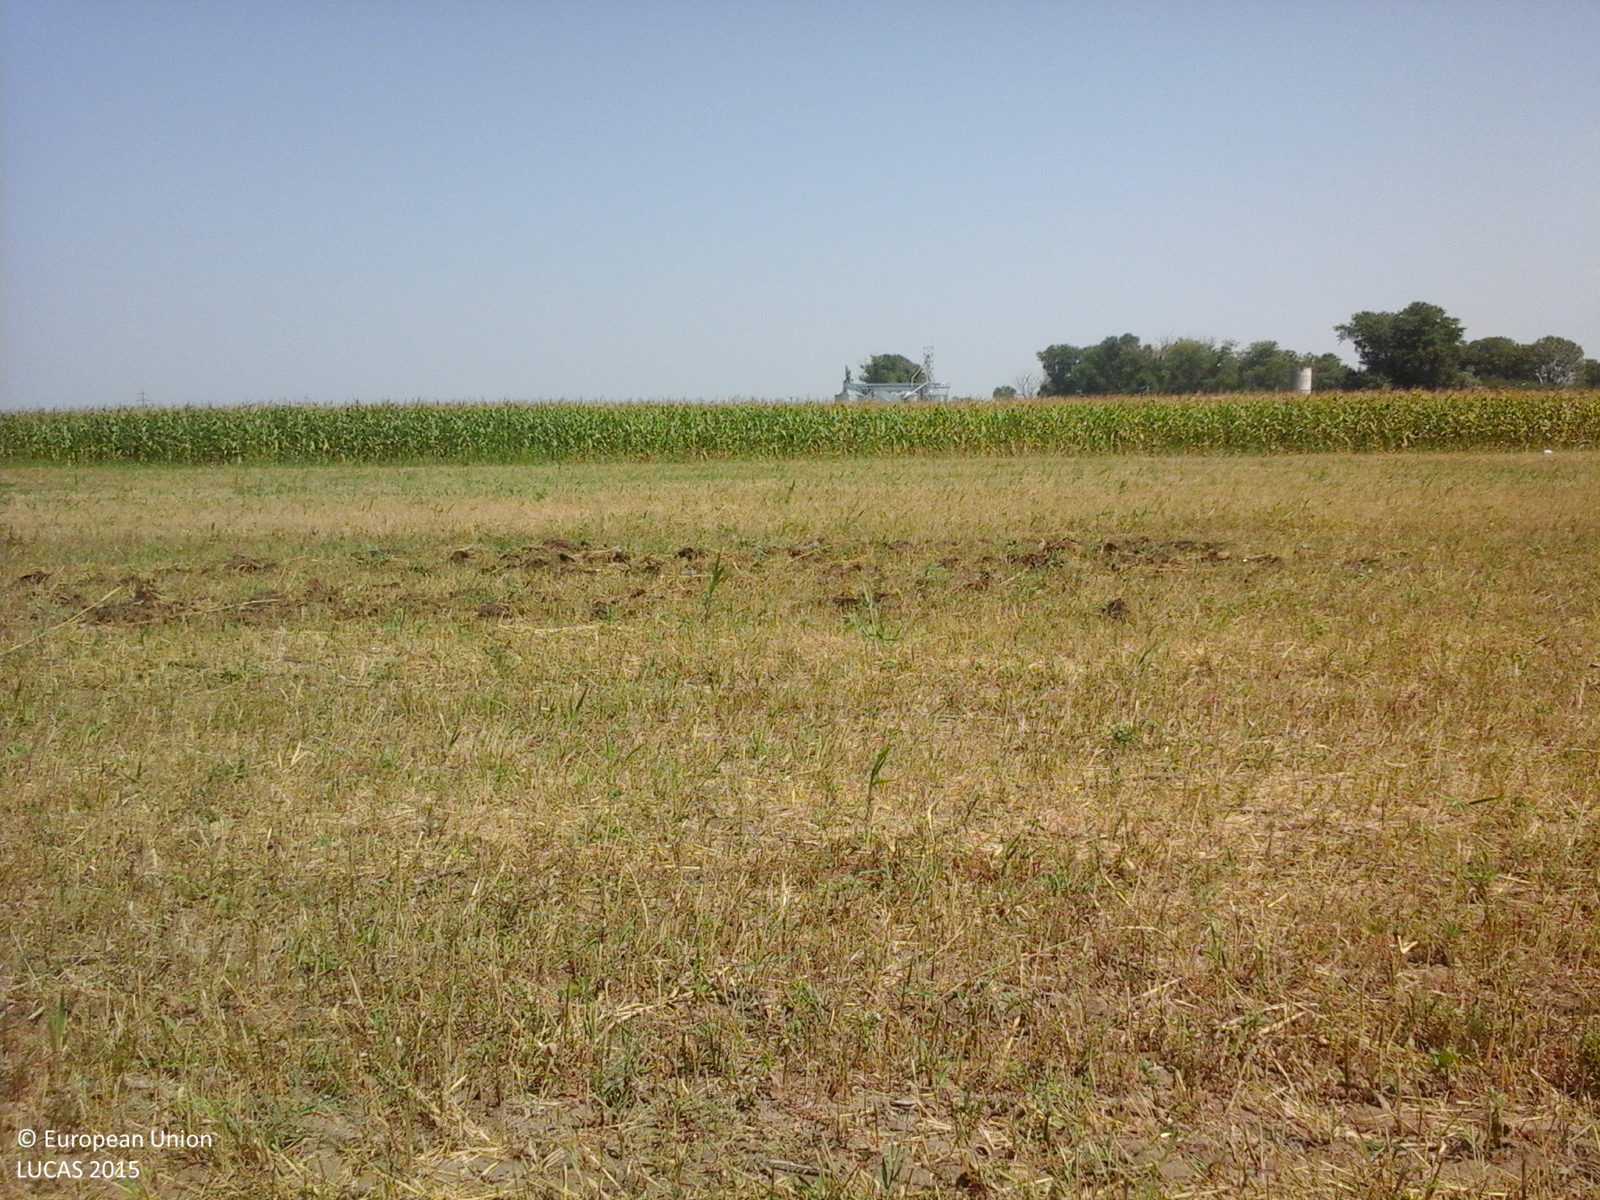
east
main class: Cropland
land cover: Maize
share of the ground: > 75 %
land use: Agriculture (excluding fallow land and kitchen gardens)
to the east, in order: Maize; Common wheat; Maize; Sunflower; Maize
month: August
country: RO
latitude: 45.2989
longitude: 27.7180
